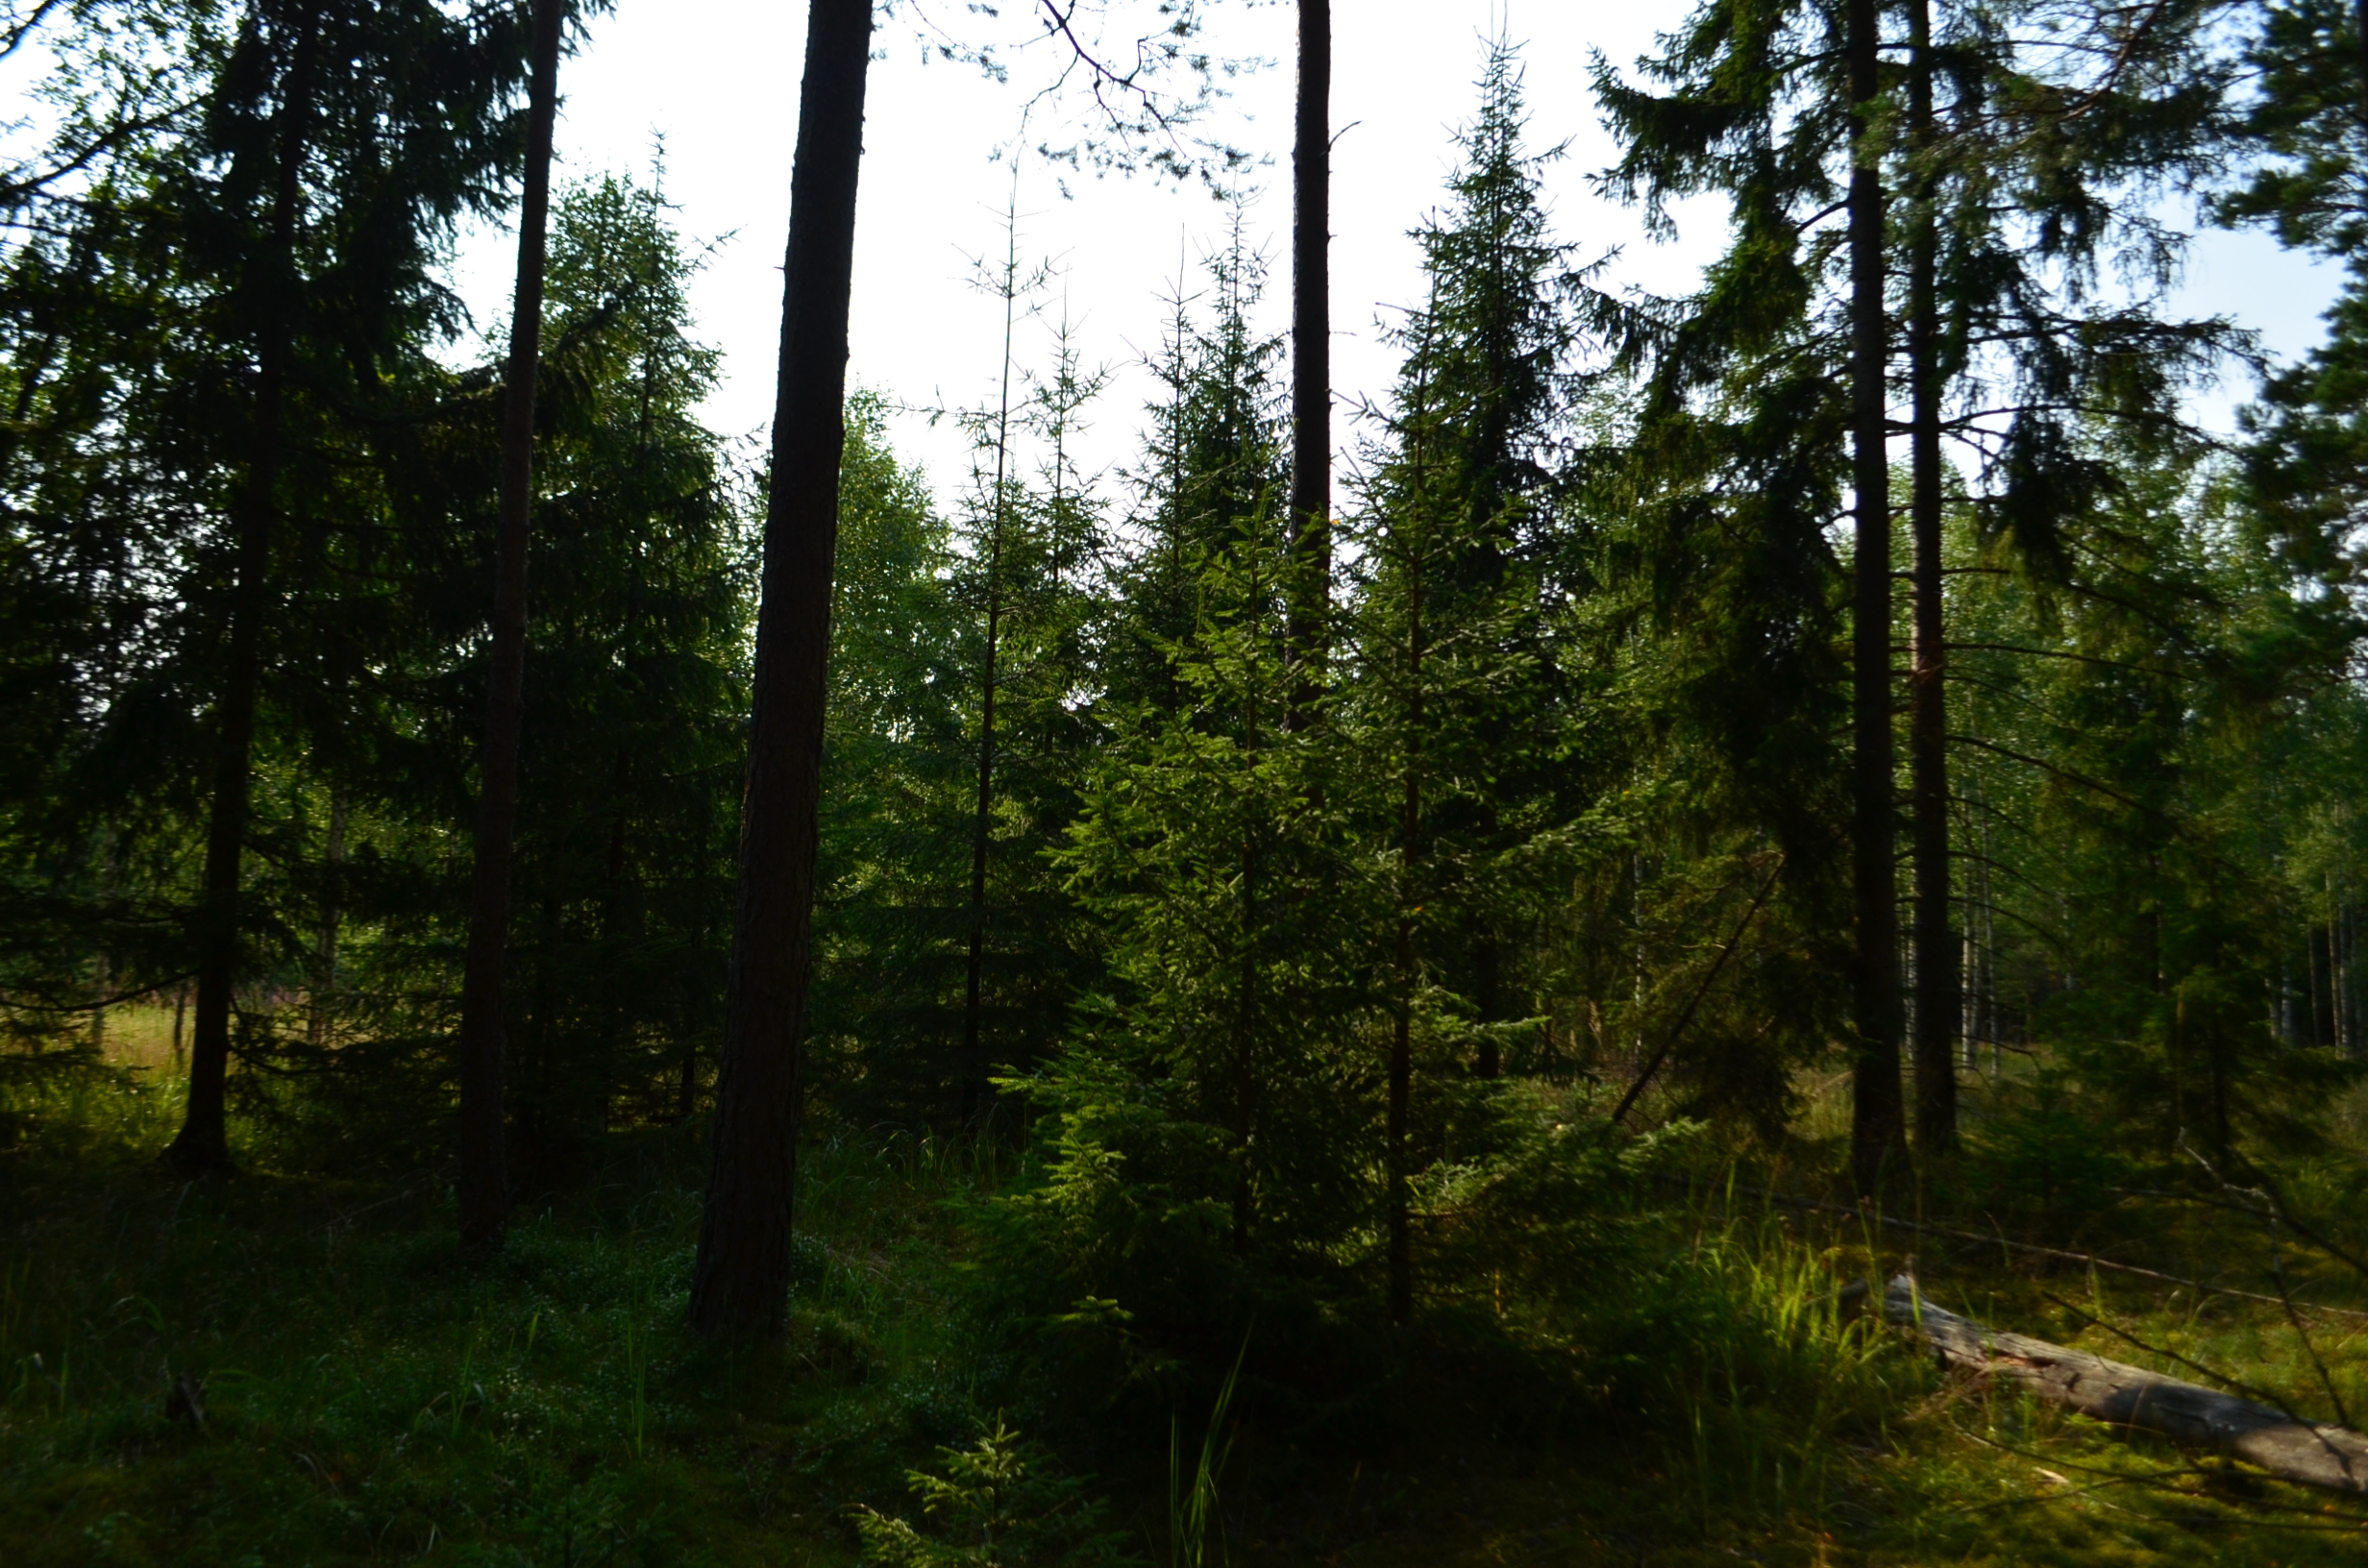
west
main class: Woodland
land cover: Other coniferous woodland
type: hemiboreal forest and nemoral coniferous forest and mixed broadleaved-coniferous forest
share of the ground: 50 - 75 %
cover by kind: coniferous forest trees 60 %, broadleaved forest trees 10 %, shrubs 10 %, herbaceous plants 10 %, lichens and mosses 10 %
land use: Forestry
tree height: > 5 m
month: August
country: LV
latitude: 57.2903
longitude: 21.8744
